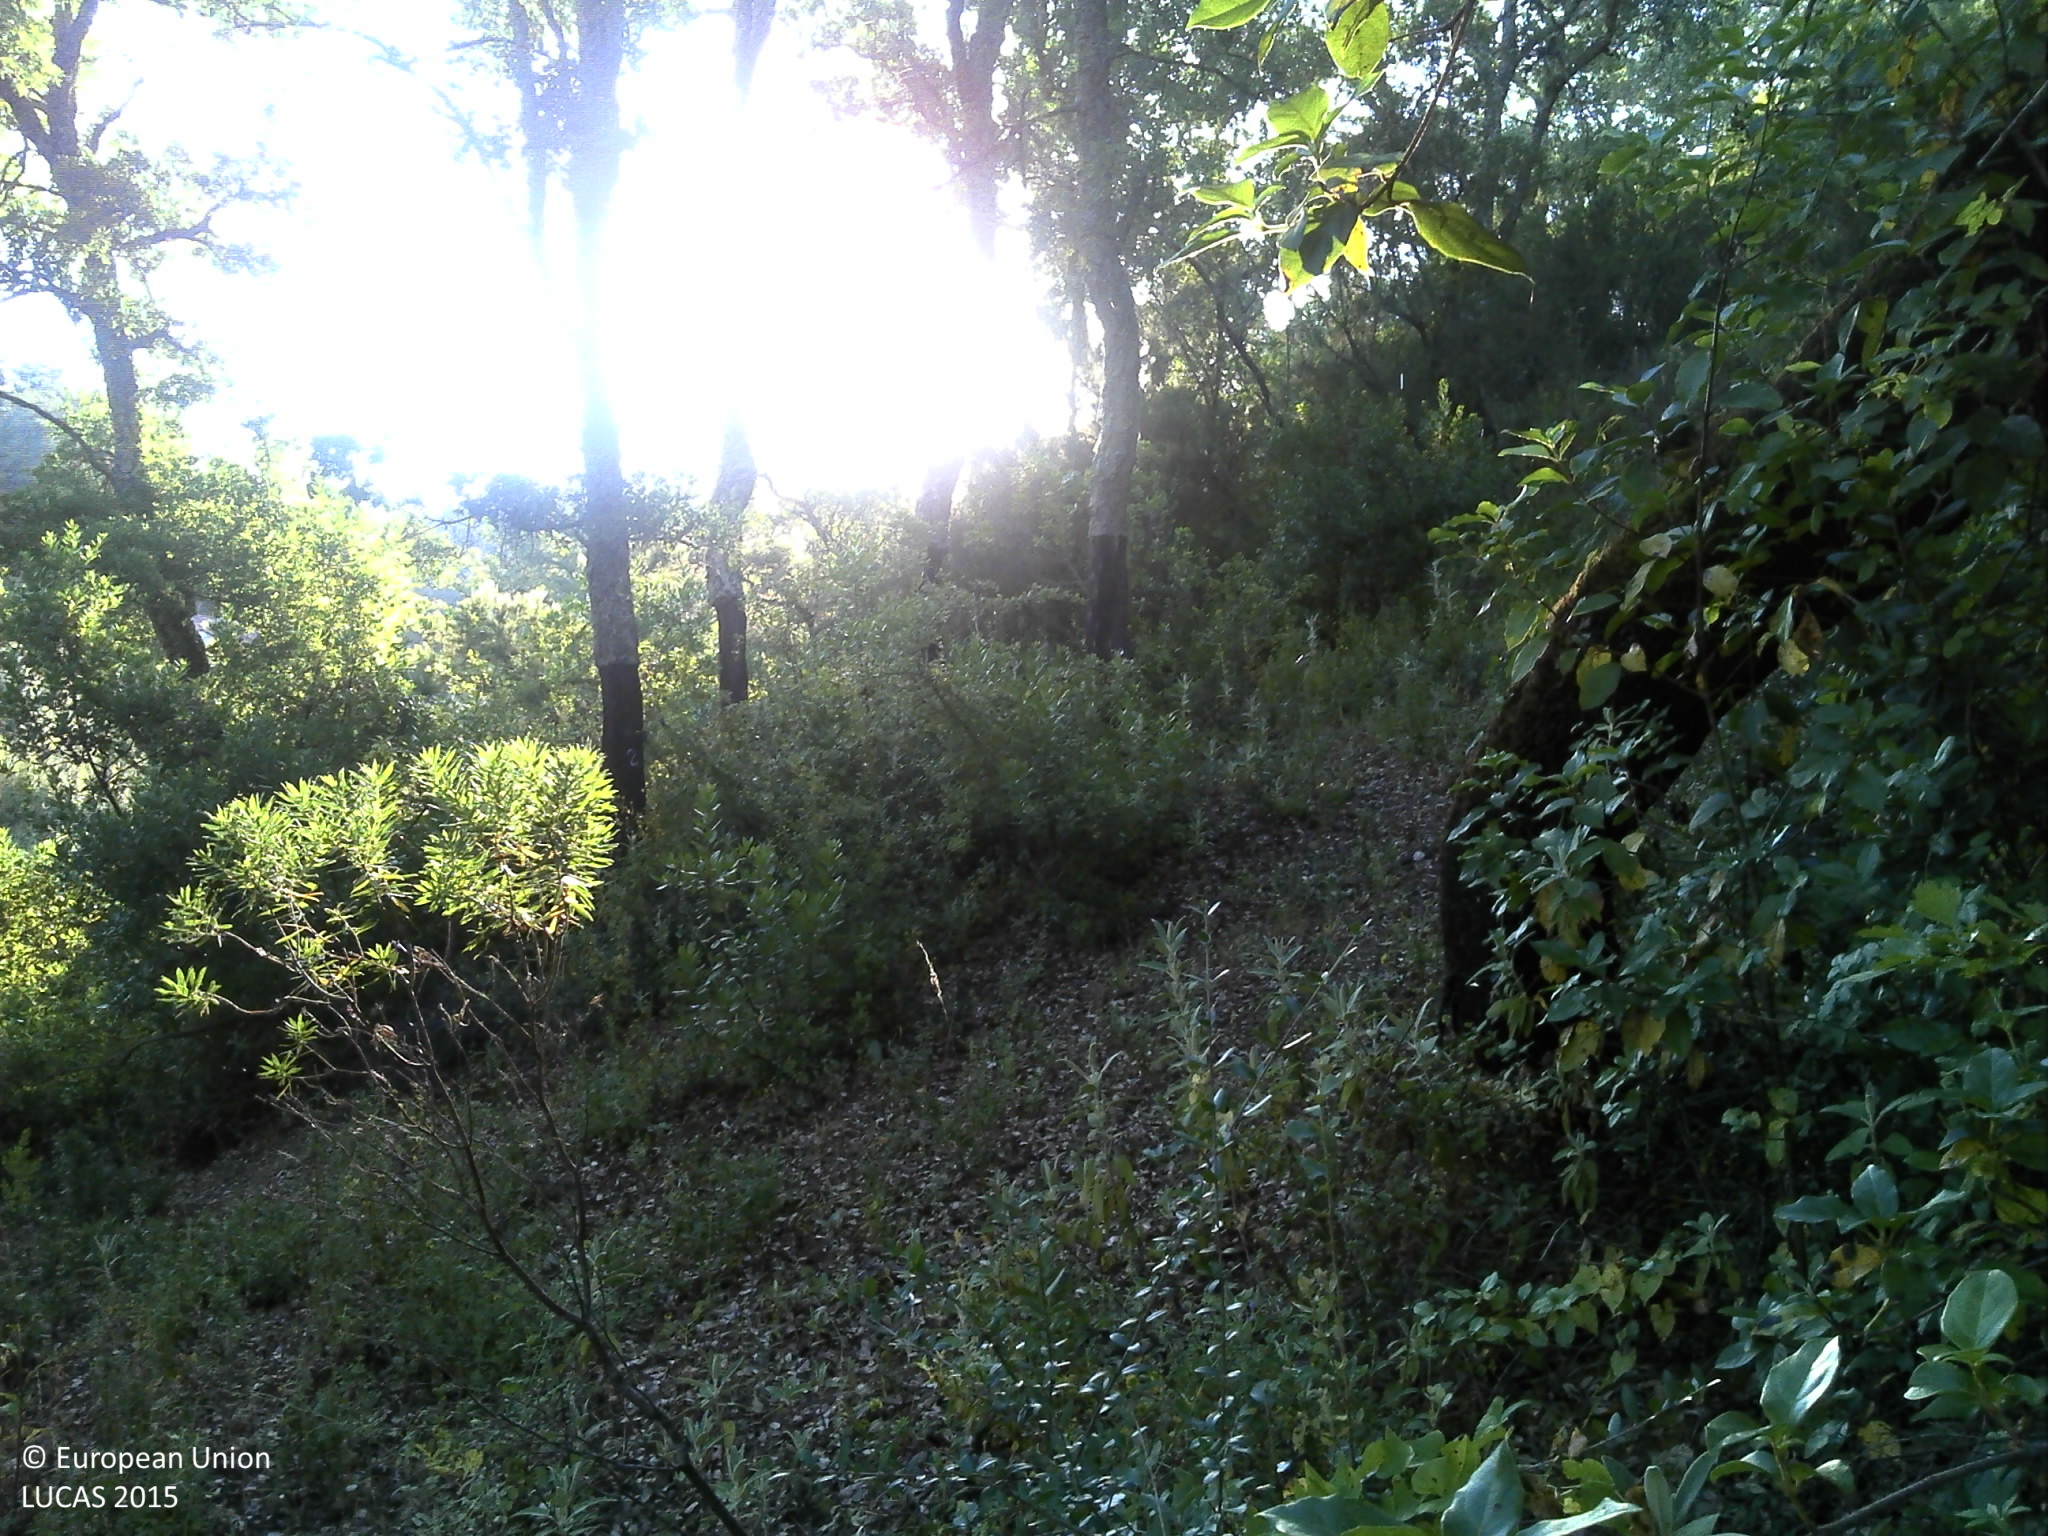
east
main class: Woodland
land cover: Broadleaved woodland
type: broadleaved evergreen forest
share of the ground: 25 - 50 %
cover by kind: broadleaved forest trees 40 %, shrubs 40 %, herbaceous plants 10 %, unconsolidated bare surface 10 %
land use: Forestry
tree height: > 5 m
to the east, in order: Broadleaved woodland; Tracks; Broadleaved woodland
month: June
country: PT
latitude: 37.6703
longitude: -8.5280
